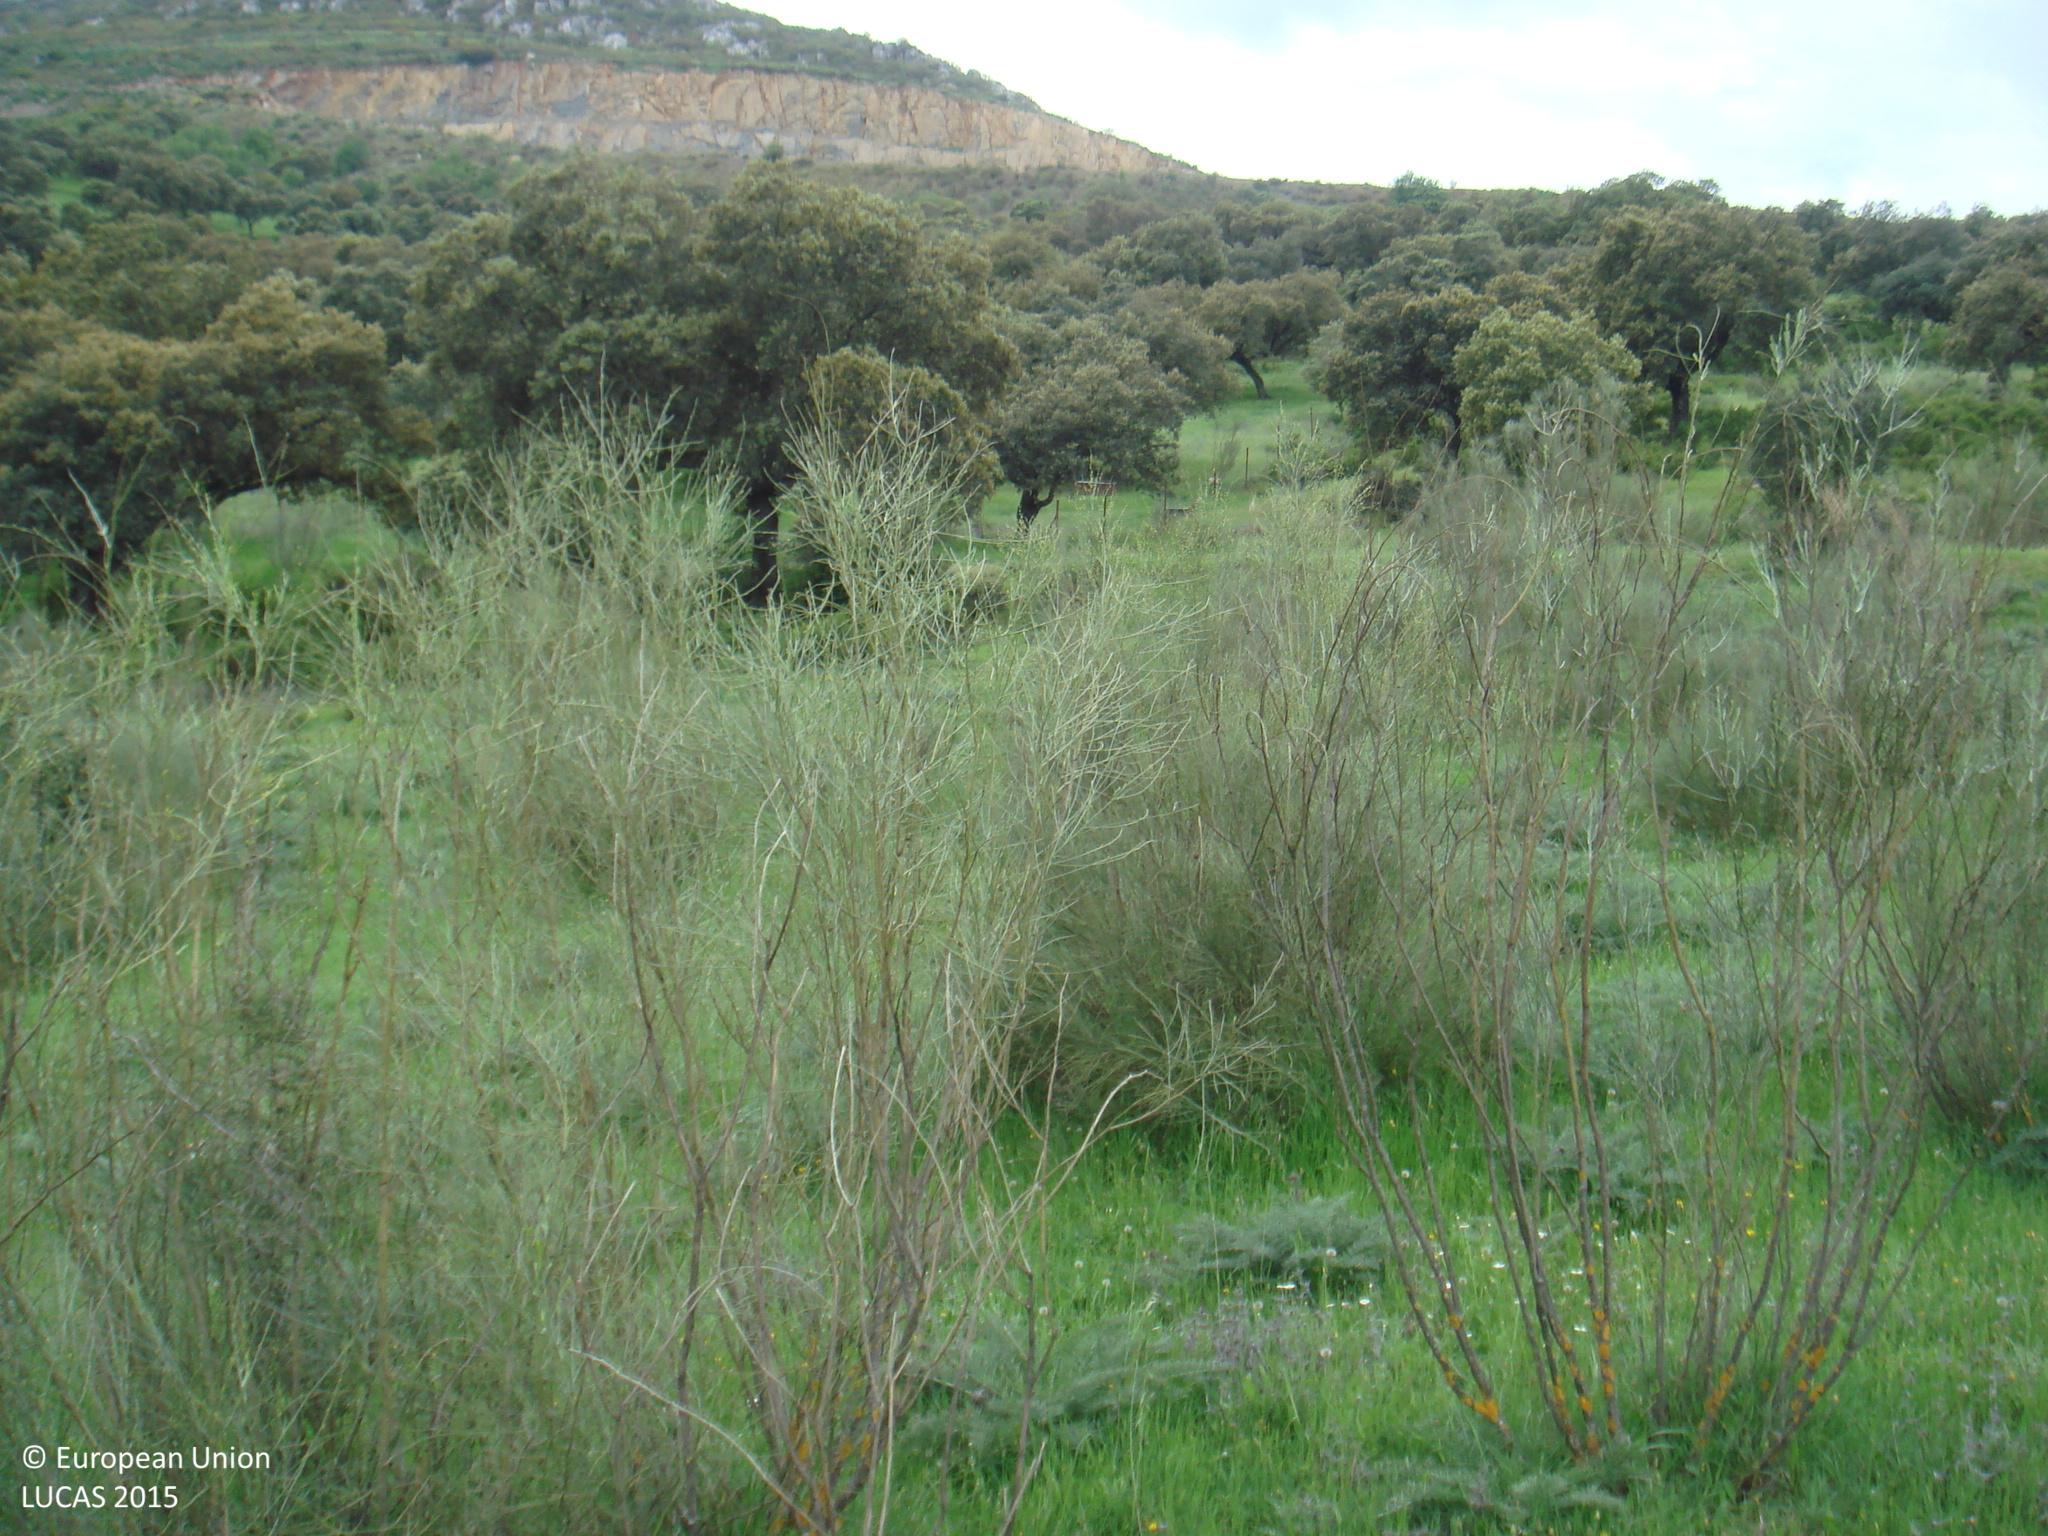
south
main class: Shrubland
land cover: Shrubland with sparse tree cover
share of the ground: > 75 %
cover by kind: shrubs 70 %, herbaceous plants 25 %, broadleaved forest trees 5 %
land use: Forestry
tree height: > 5 m
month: April
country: ES
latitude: 38.1823
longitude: -5.0354
